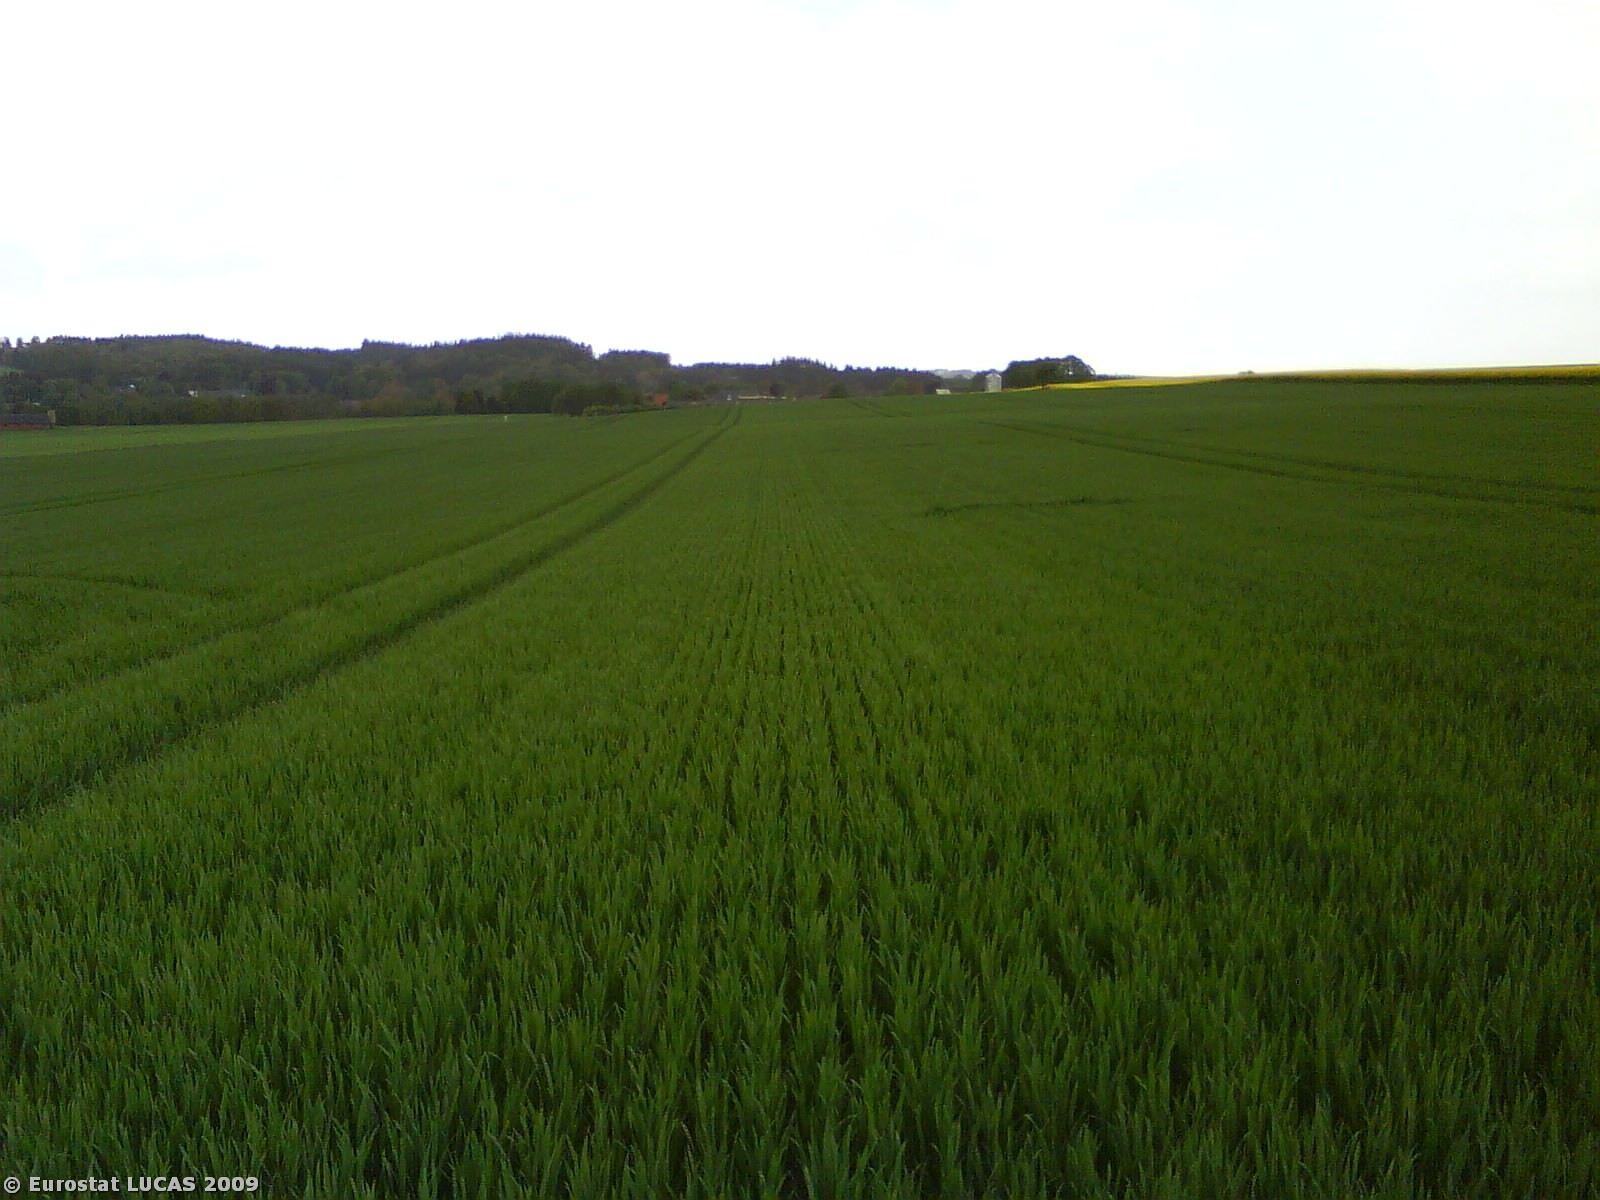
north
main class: Cropland
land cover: Common wheat
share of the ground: > 75 %
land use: Agriculture (excluding fallow land and kitchen gardens)
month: May
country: DK
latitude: 56.4031
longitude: 10.2751
